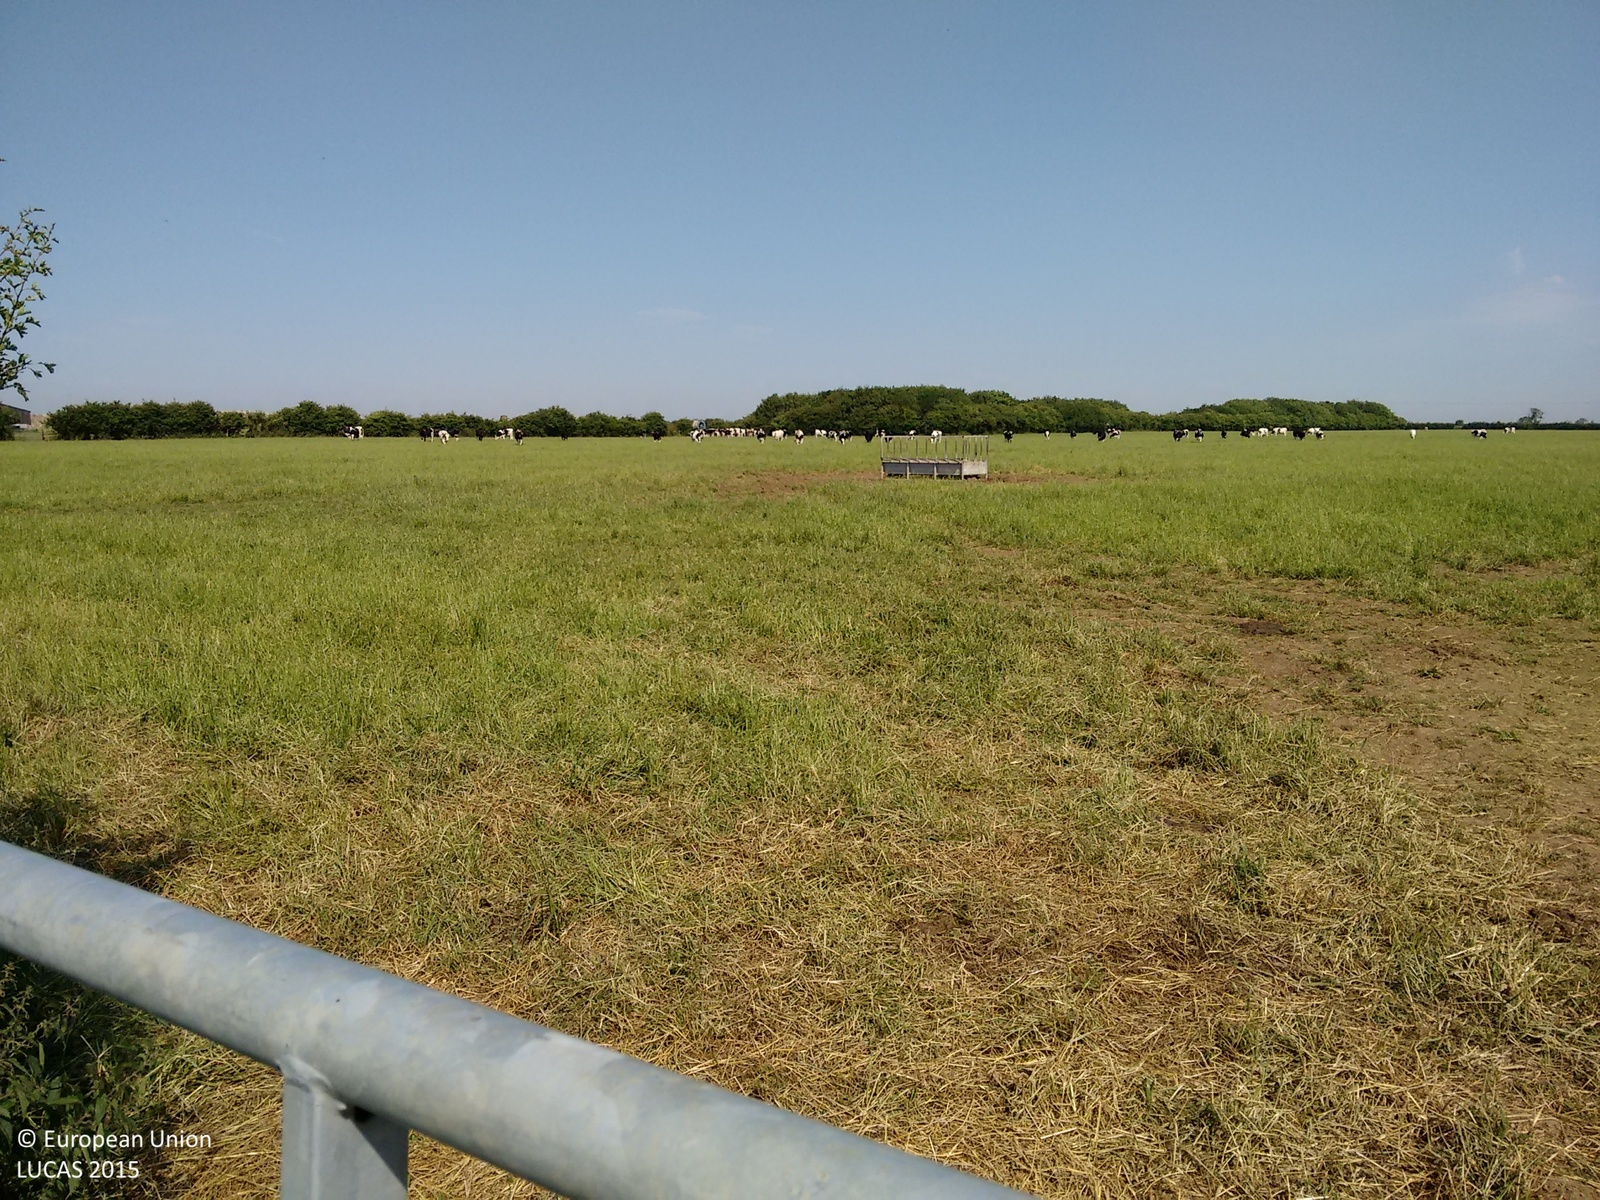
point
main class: Grassland
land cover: Grassland without tree/shrub cover
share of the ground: > 75 %
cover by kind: herbaceous plants 100 %
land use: Agriculture (excluding fallow land and kitchen gardens)
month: July
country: GB
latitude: 53.4005
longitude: -0.6728
